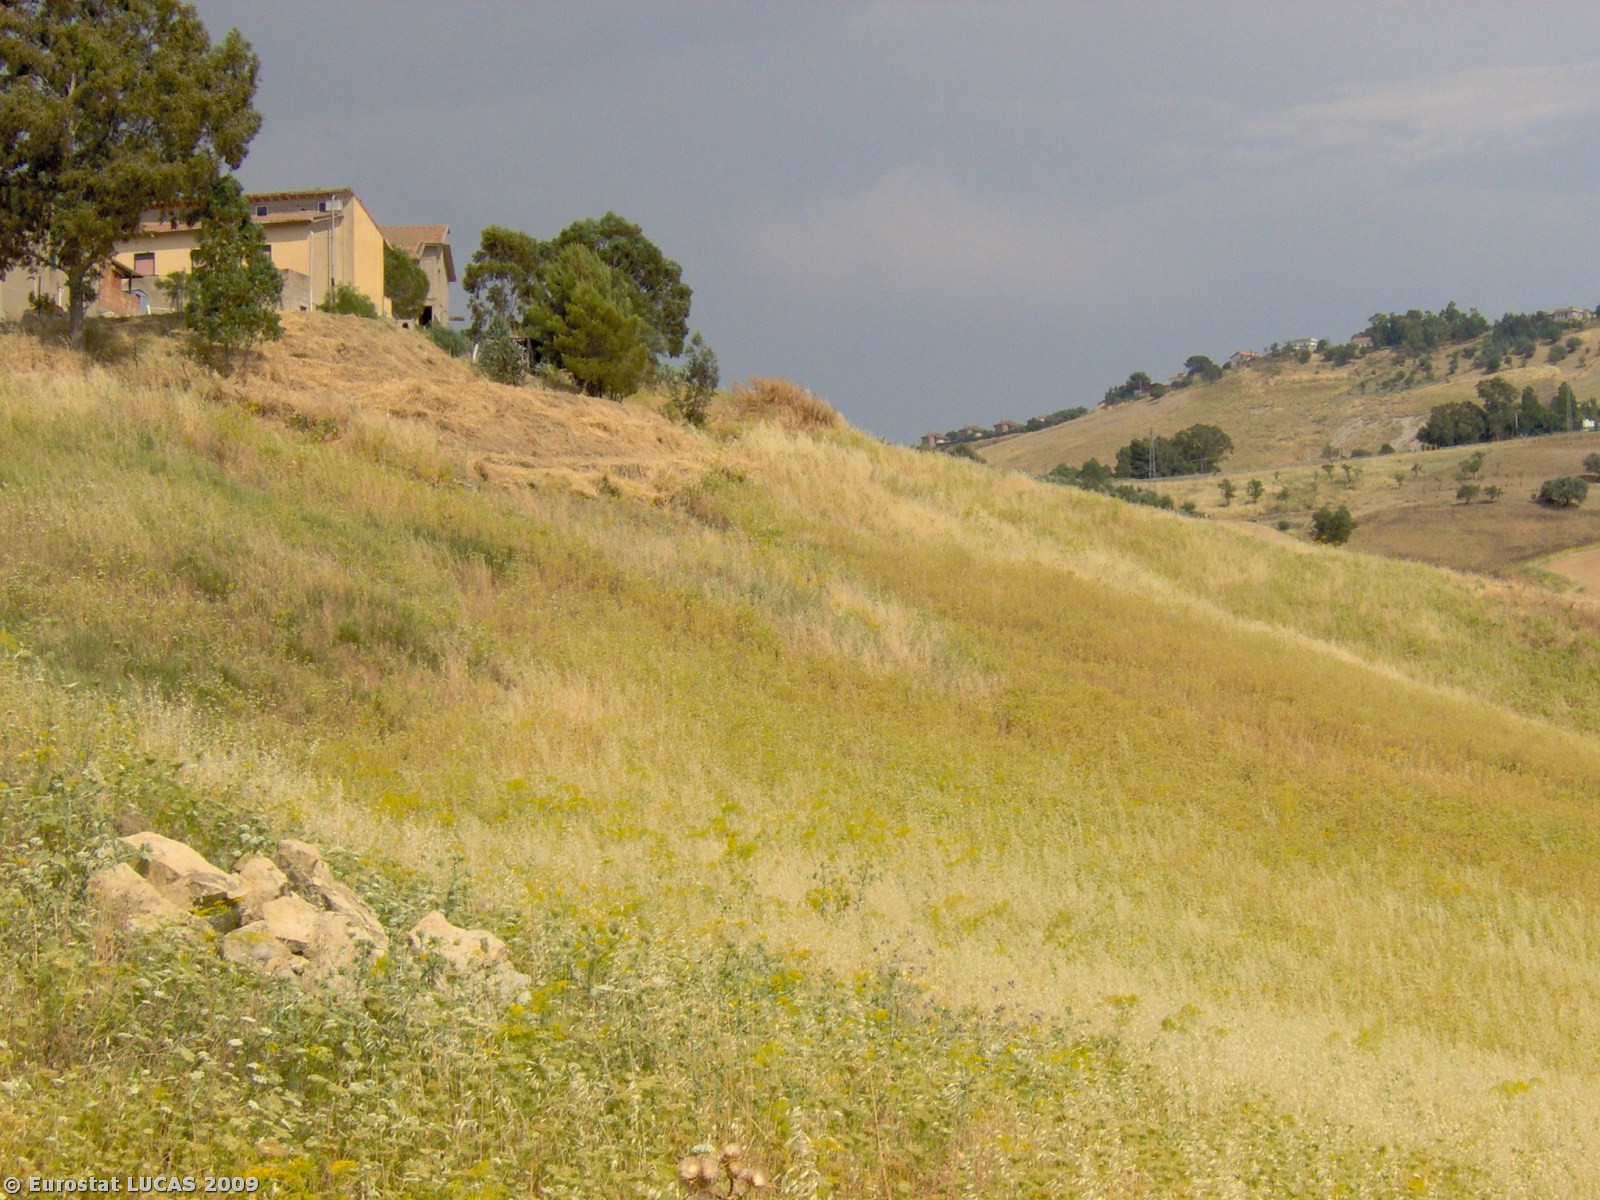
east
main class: Grassland
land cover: Spontaneously vegetated surfaces
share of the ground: > 75 %
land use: Fallow land
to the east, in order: Spontaneously vegetated surfaces; Fences; Artificial constructions in urban areas; Spontaneously vegetated surfaces; Tracks; Spontaneously vegetated surfaces; Paved roads, cycling and walking lanes; Grass margins; Paved roads, cycling and walking lanes; Olive groves; Bare land; Grass margins; Paved roads, cycling and walking lanes; Grass margins; Olive groves; Bare land
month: June
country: IT
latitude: 37.5157
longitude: 14.0541
